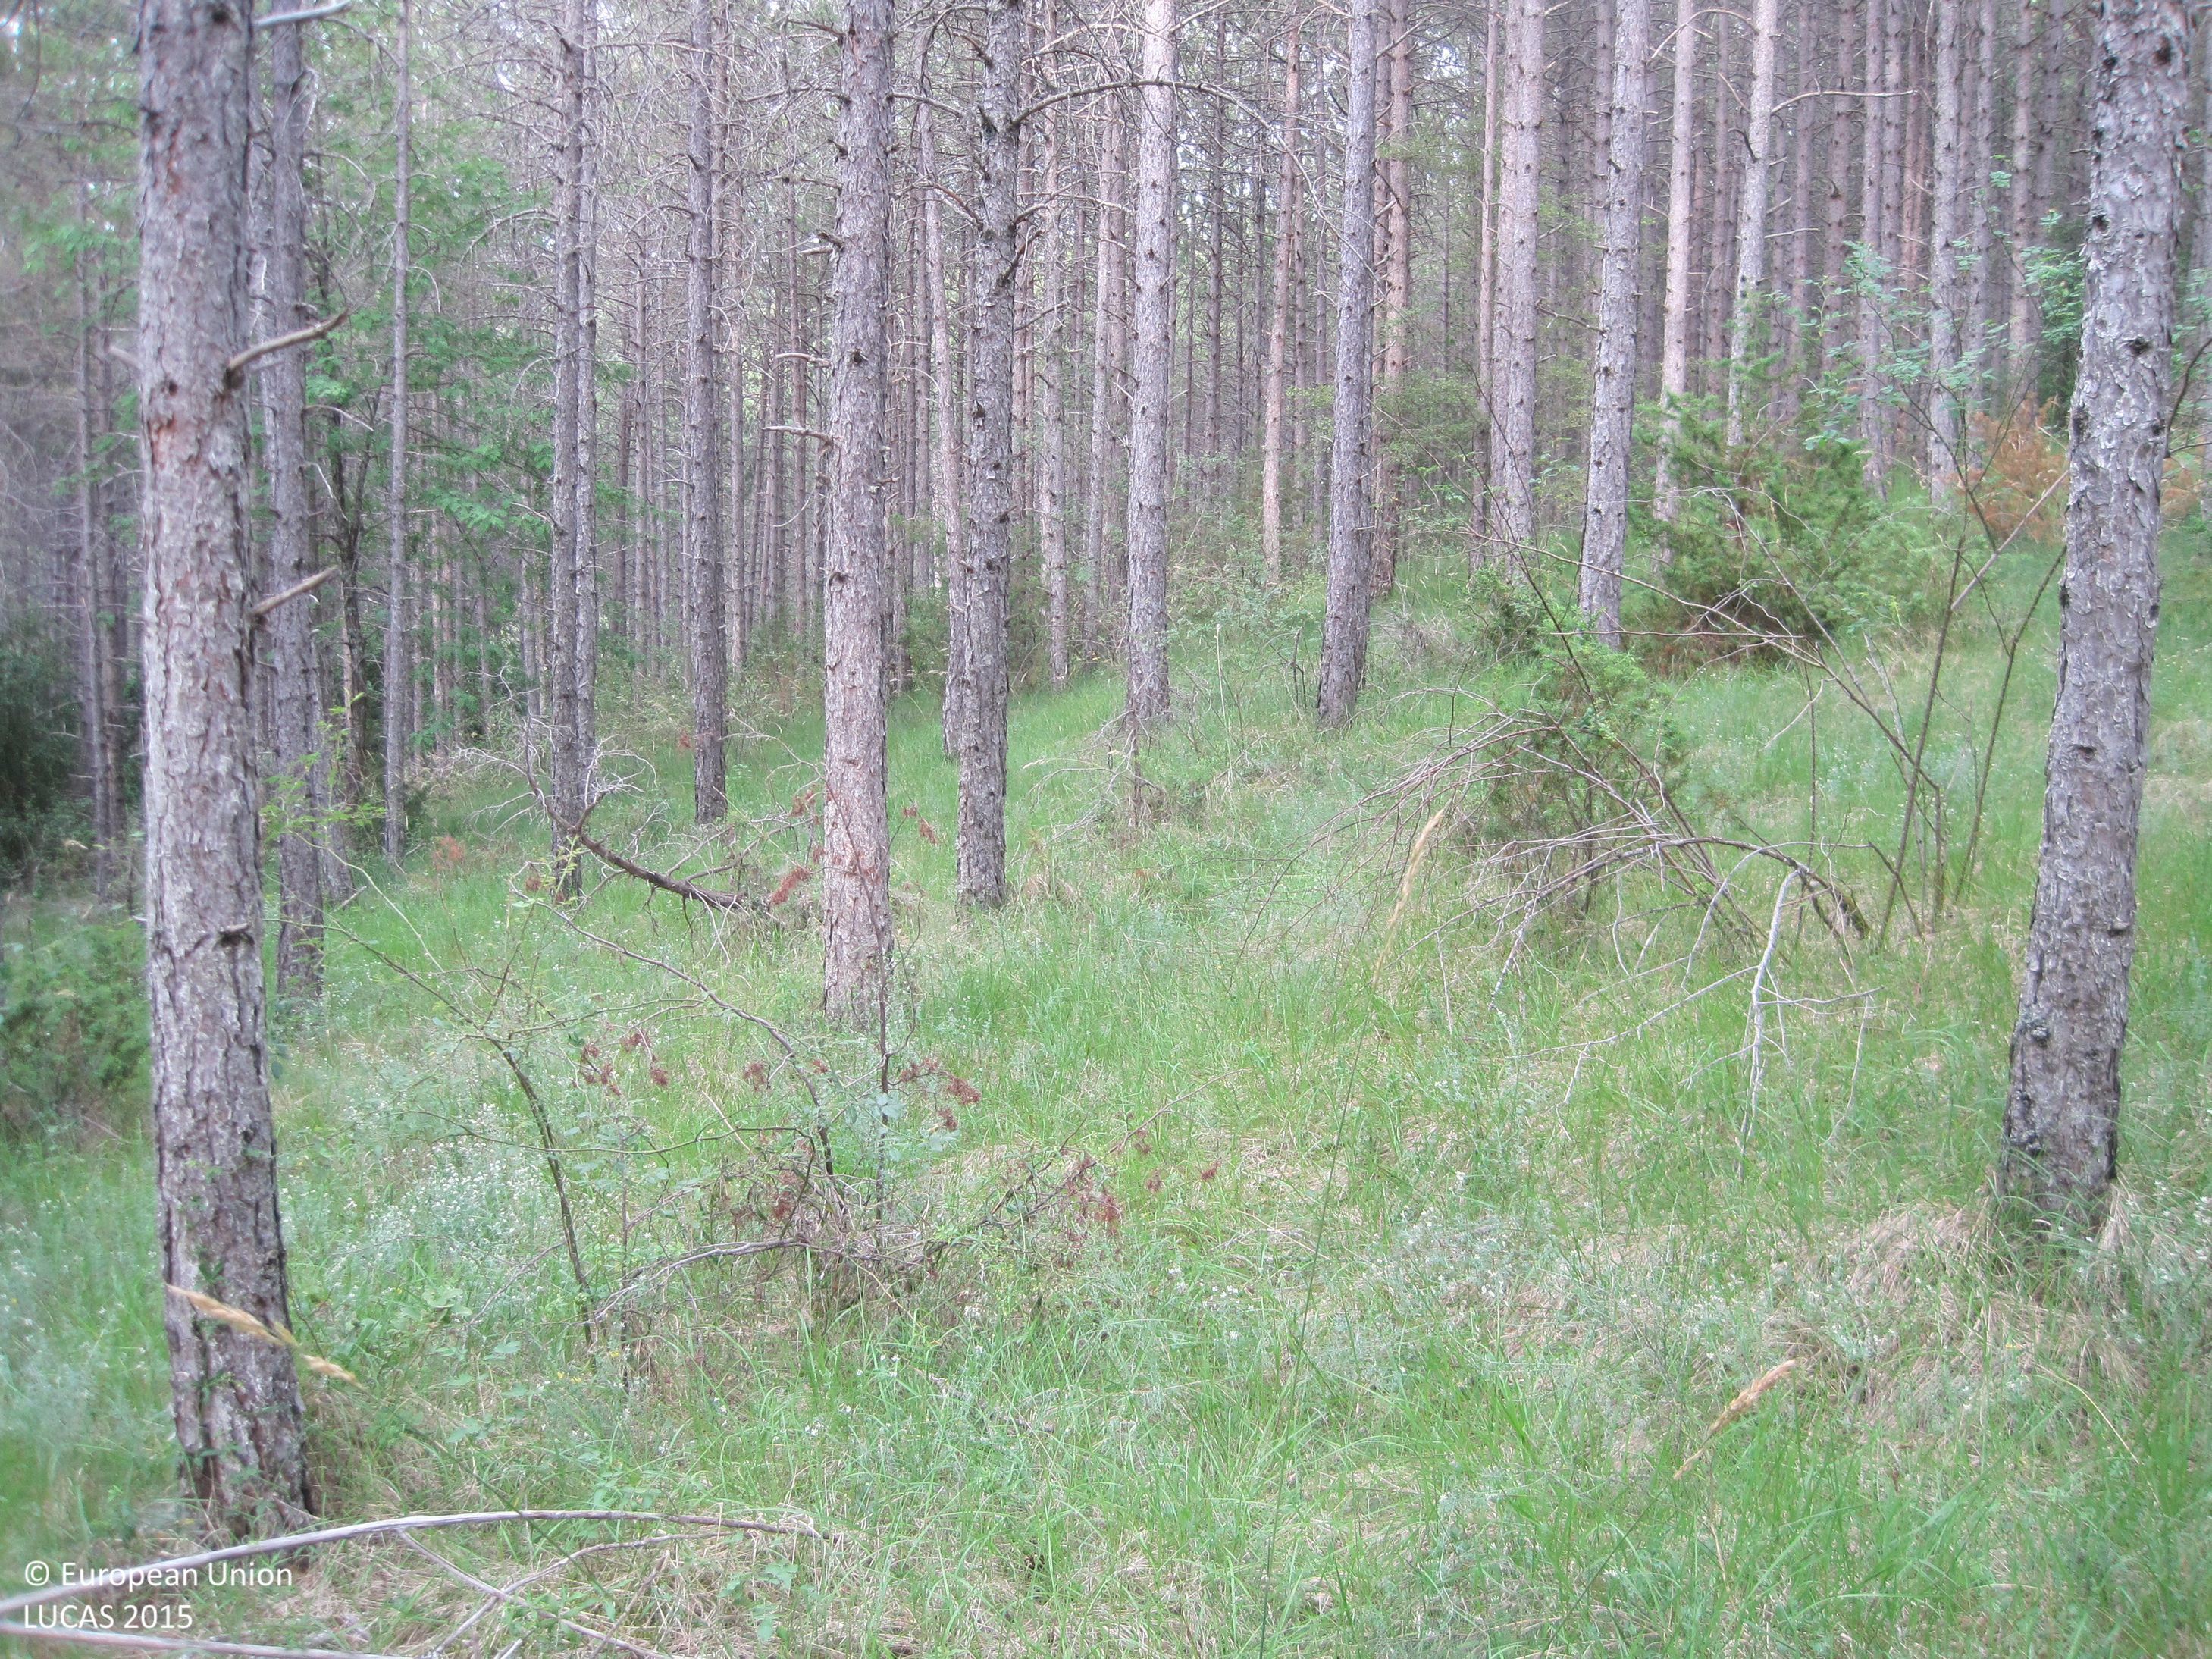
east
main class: Woodland
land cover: Pine dominated coniferous woodland
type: coniferous forest of the mediterranean region
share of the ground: > 75 %
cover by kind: coniferous forest trees 95 %, herbaceous plants 5 %
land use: Forestry
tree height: > 5 m
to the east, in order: Pine dominated coniferous woodland
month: June
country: ES
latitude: 42.7729
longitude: -1.2421
